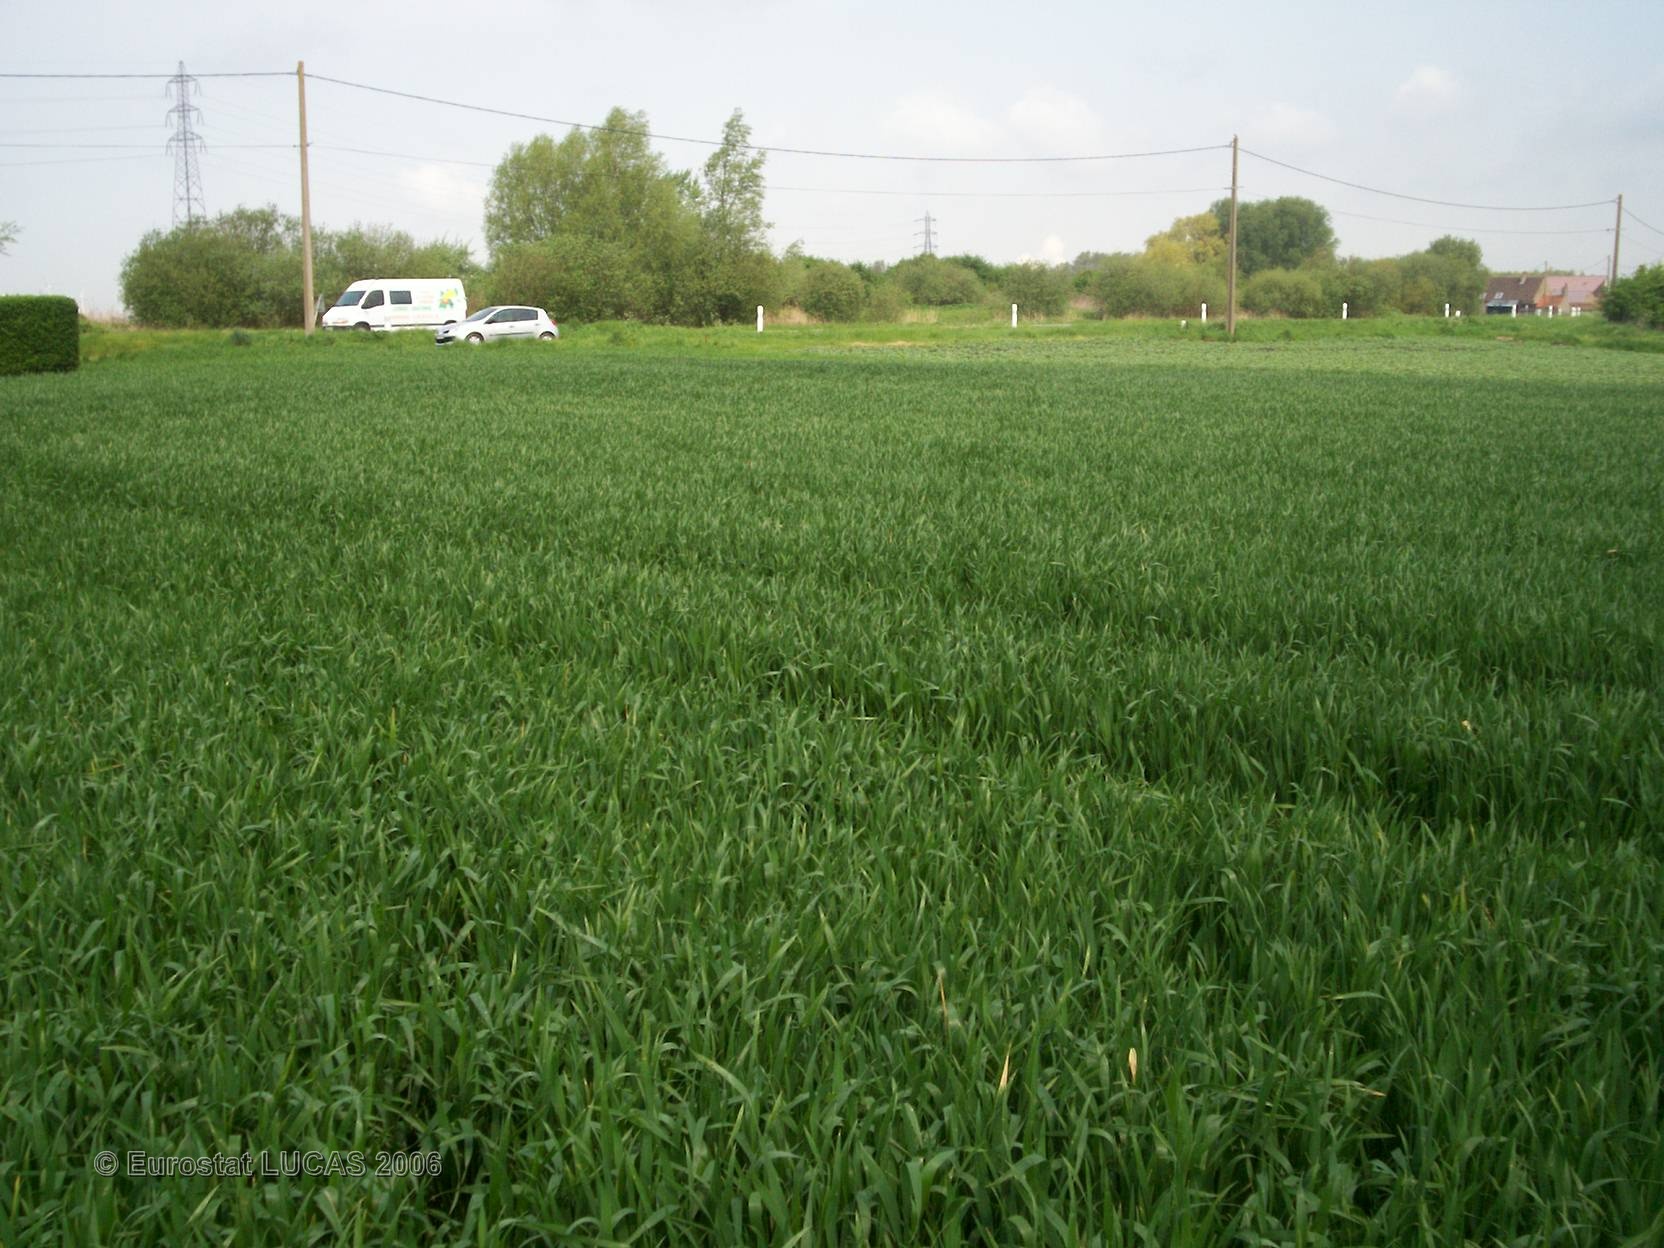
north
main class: Cropland
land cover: Common wheat
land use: Agriculture (excluding fallow land and kitchen gardens)
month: May
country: FR
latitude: 50.9701
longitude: 2.2818
